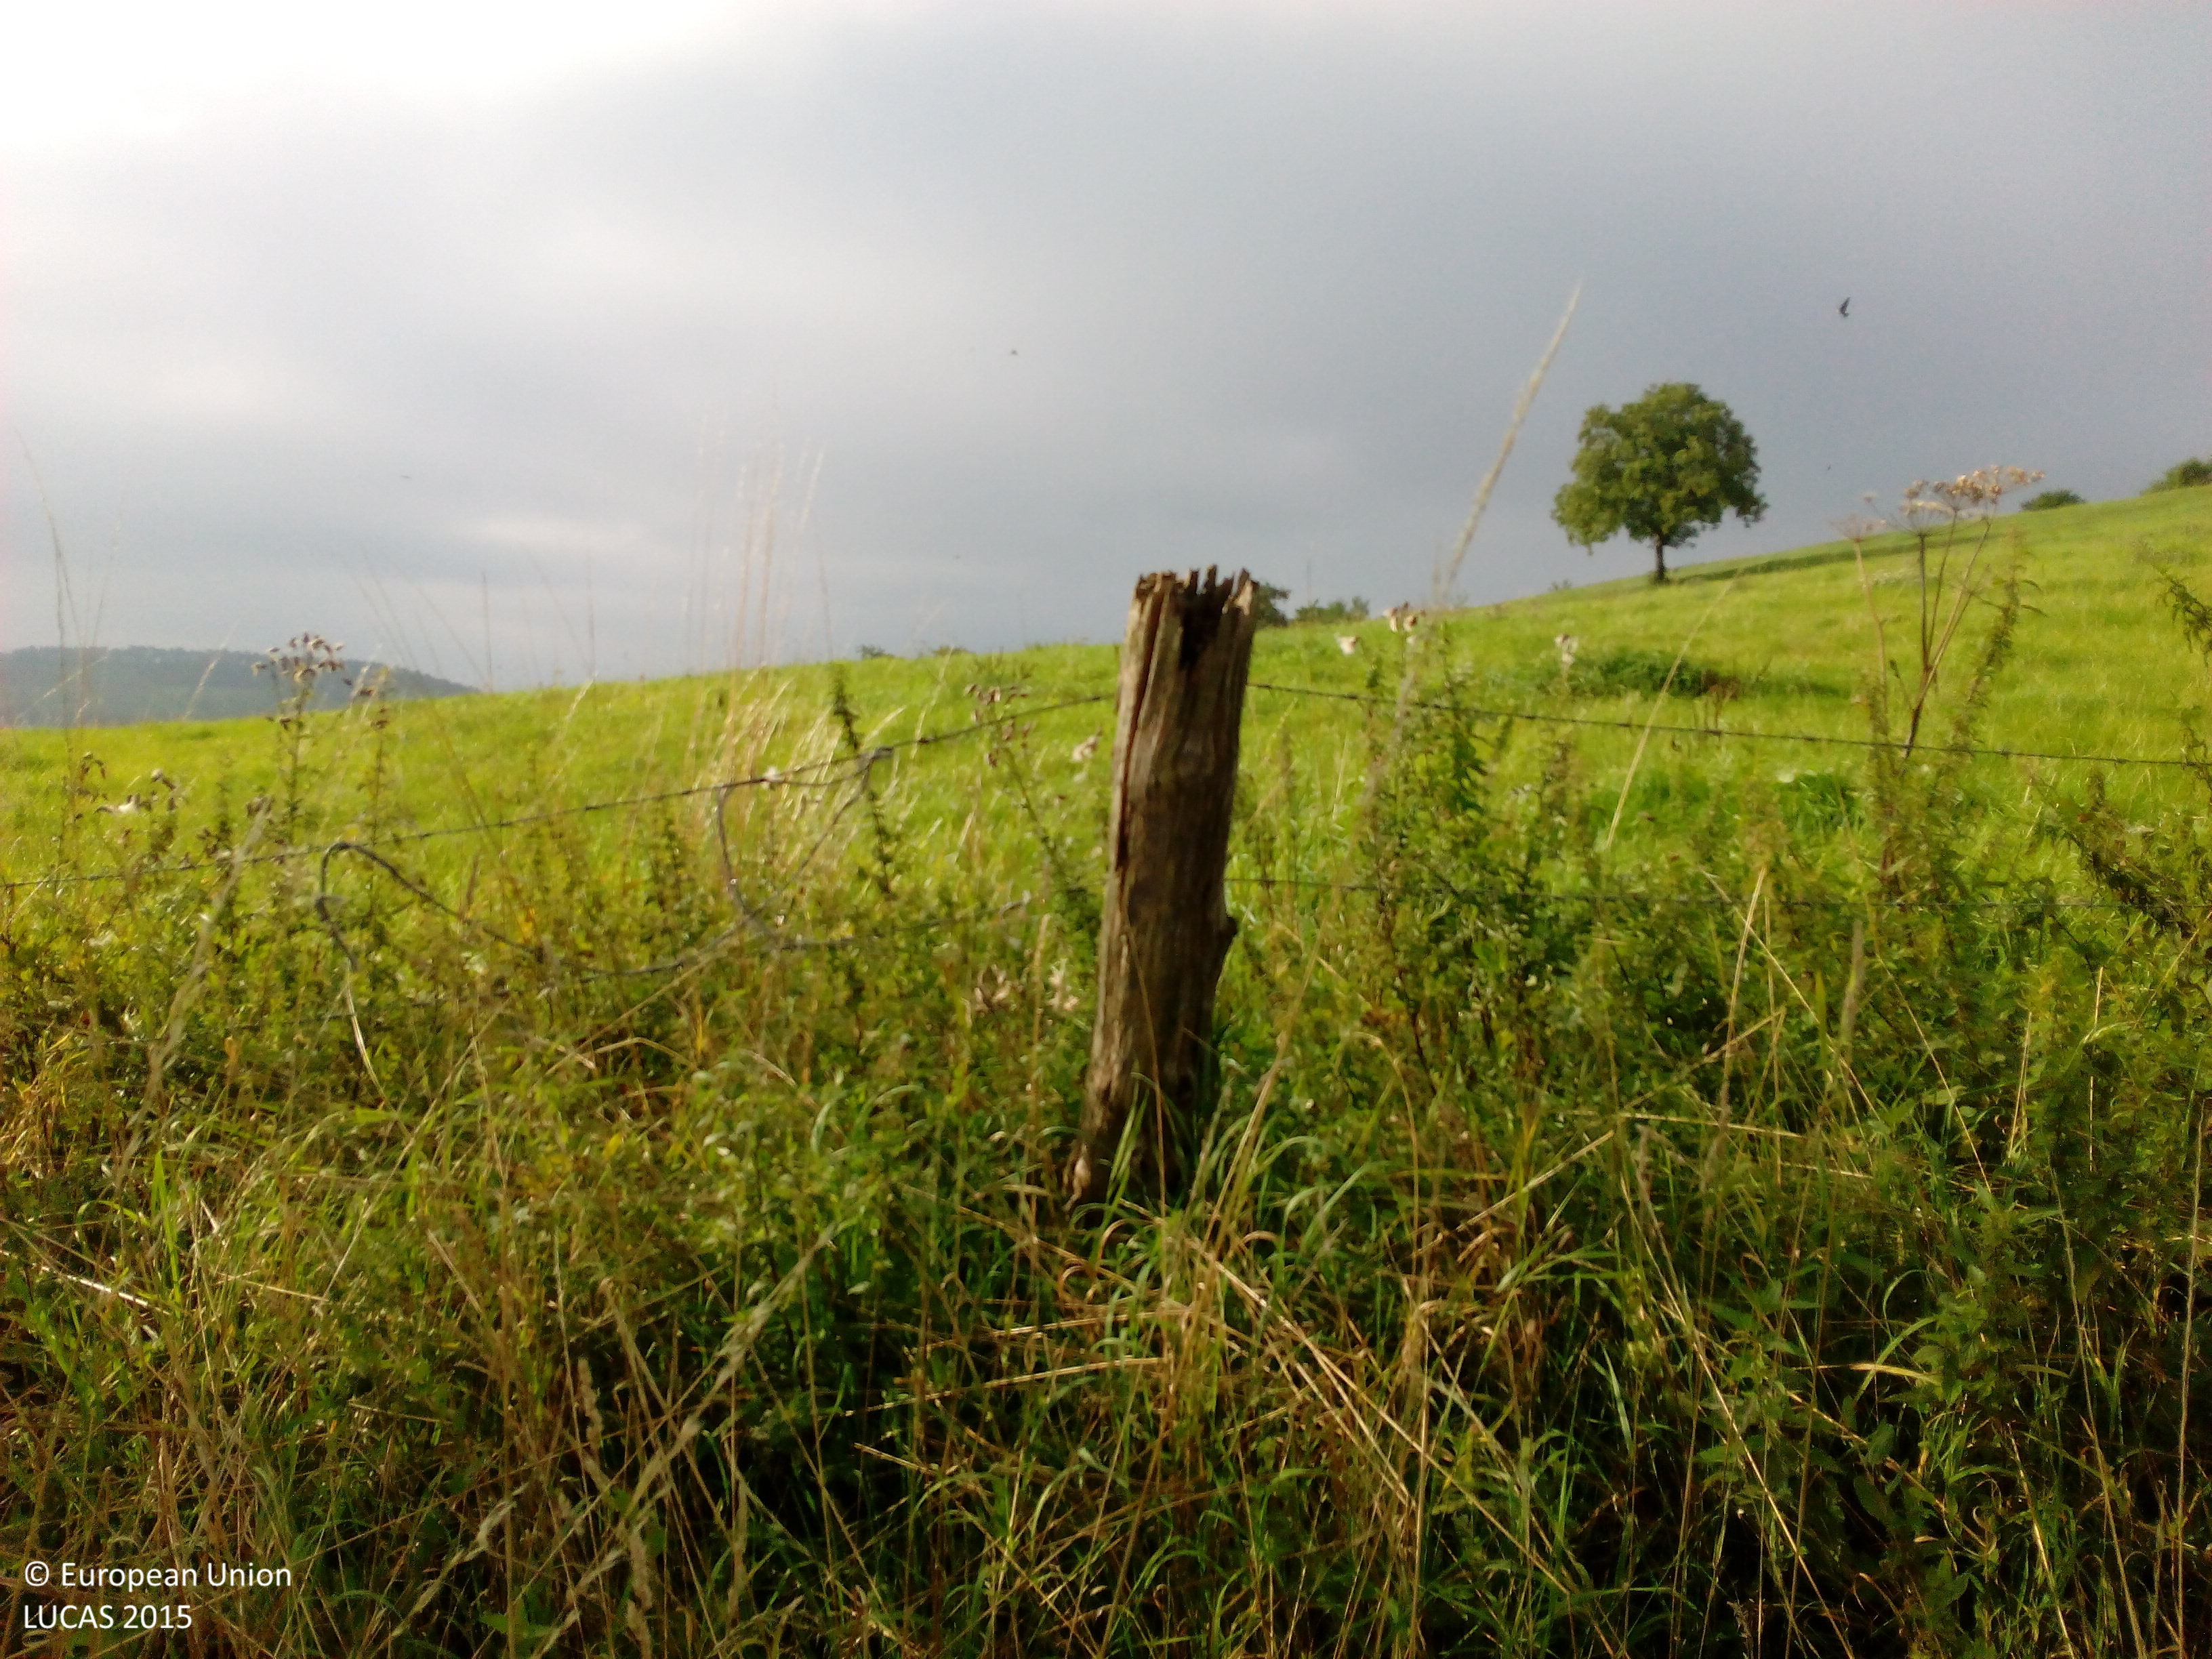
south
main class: Grassland
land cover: Grassland with sparse tree/shrub cover
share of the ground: > 75 %
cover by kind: herbaceous plants 90 %, broadleaved forest trees 5 %, shrubs 5 %
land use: Agriculture (excluding fallow land and kitchen gardens)
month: September
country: DE
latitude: 51.4068
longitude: 9.9569
